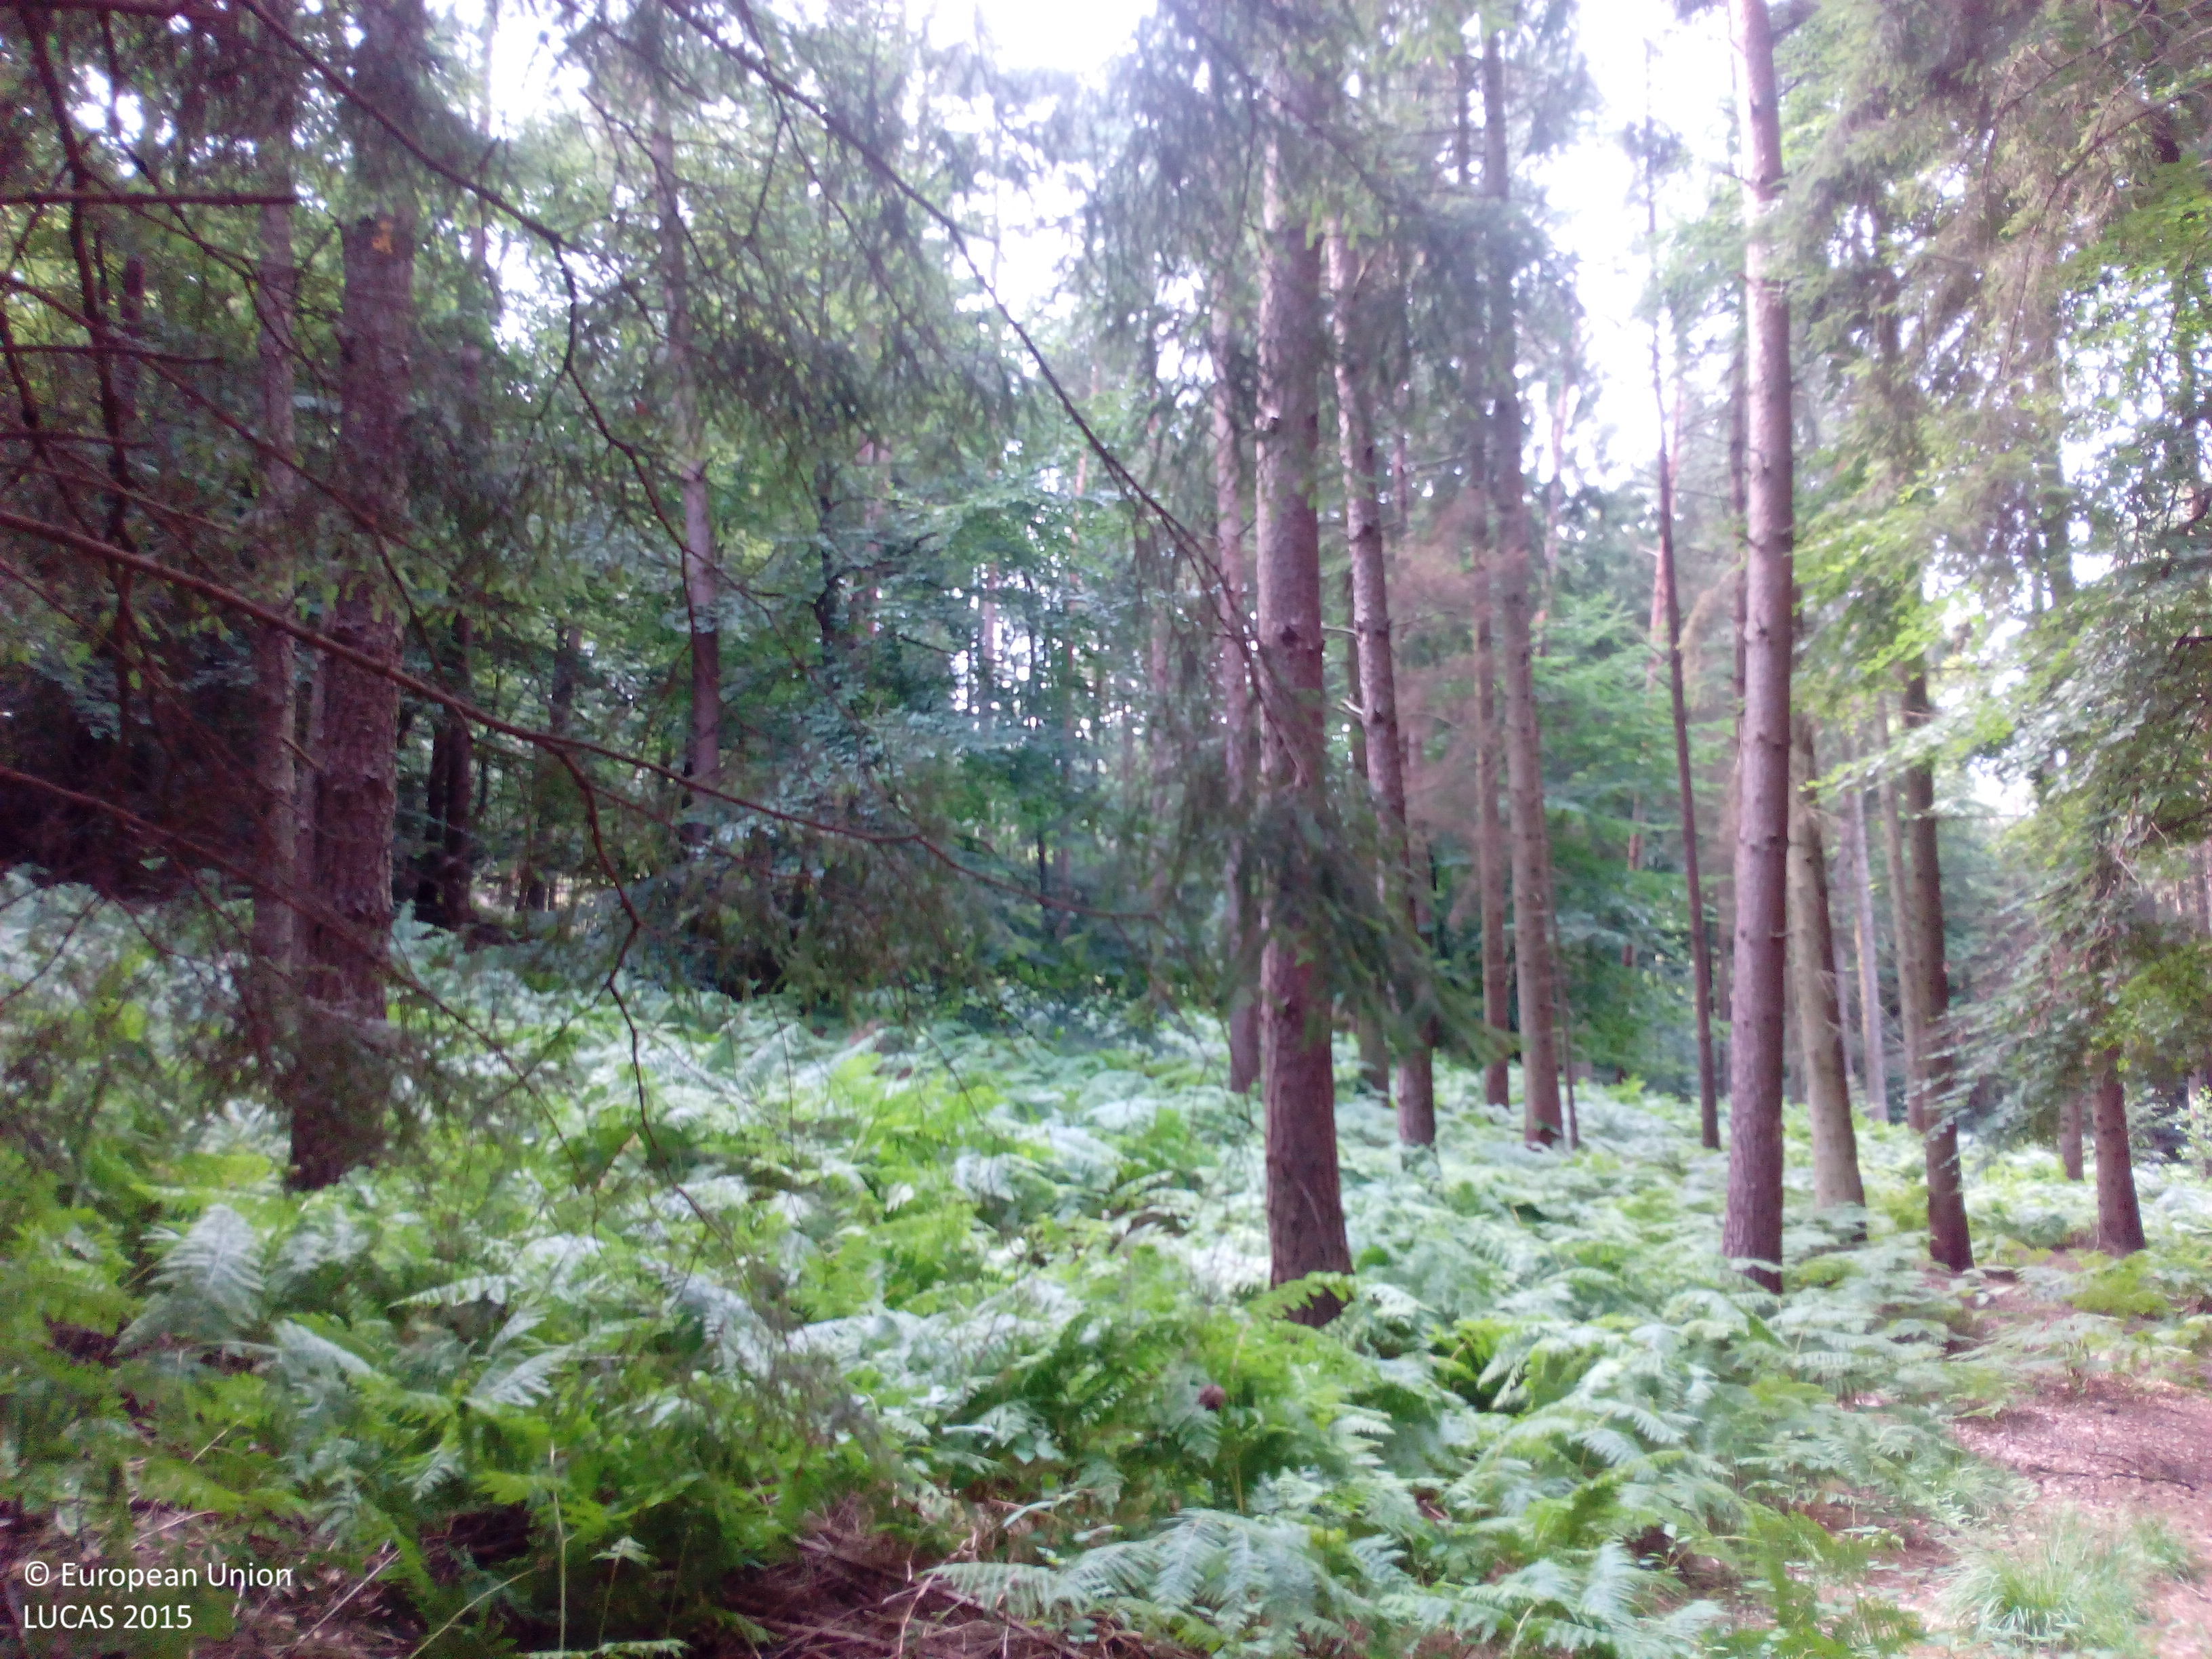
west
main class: Woodland
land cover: Spruce dominated mixed woodland
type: hemiboreal forest and nemoral coniferous forest and mixed broadleaved-coniferous forest
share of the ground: > 75 %
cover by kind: coniferous forest trees 45 %, broadleaved forest trees 45 %, shrubs 5 %, herbaceous plants 5 %
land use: Forestry
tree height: > 5 m
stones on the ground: < 10 %
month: August
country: DE
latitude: 52.3789
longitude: 8.0173
